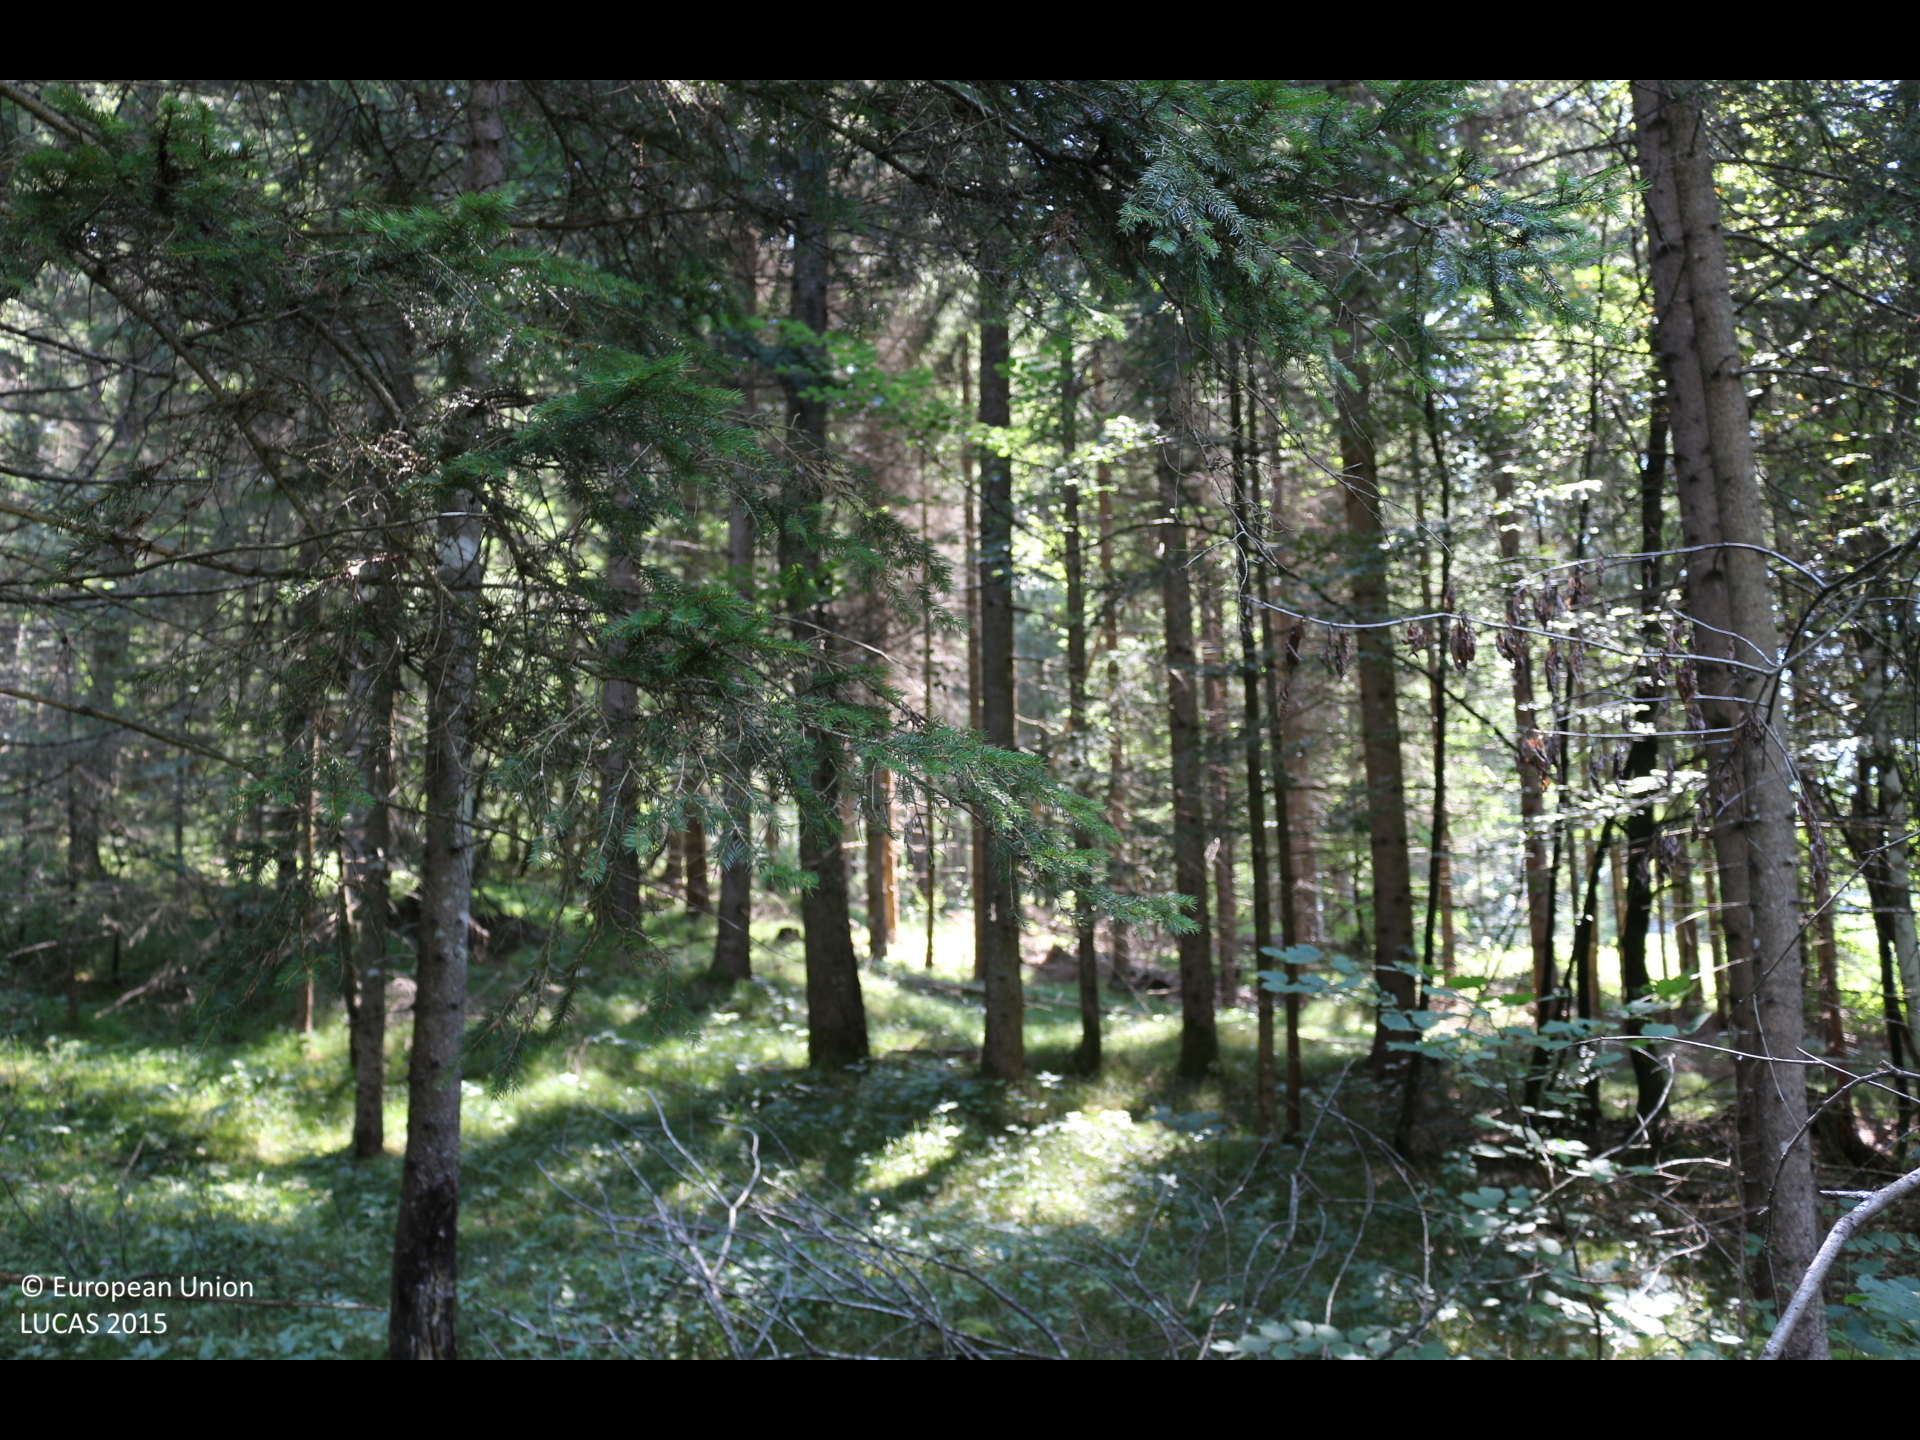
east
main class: Woodland
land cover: Spruce dominated mixed woodland
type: alpine coniferous forest
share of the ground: > 75 %
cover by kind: coniferous forest trees 65 %, broadleaved forest trees 25 %, shrubs 5 %, herbaceous plants 5 %
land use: Forestry
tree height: > 5 m
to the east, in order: Spruce dominated mixed woodland; Tracks; Spruce dominated mixed woodland; Spruce dominated coniferous woodland; Spruce dominated mixed woodland; Tracks; Spruce dominated mixed woodland
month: August
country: AT
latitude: 46.6795
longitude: 13.2787
